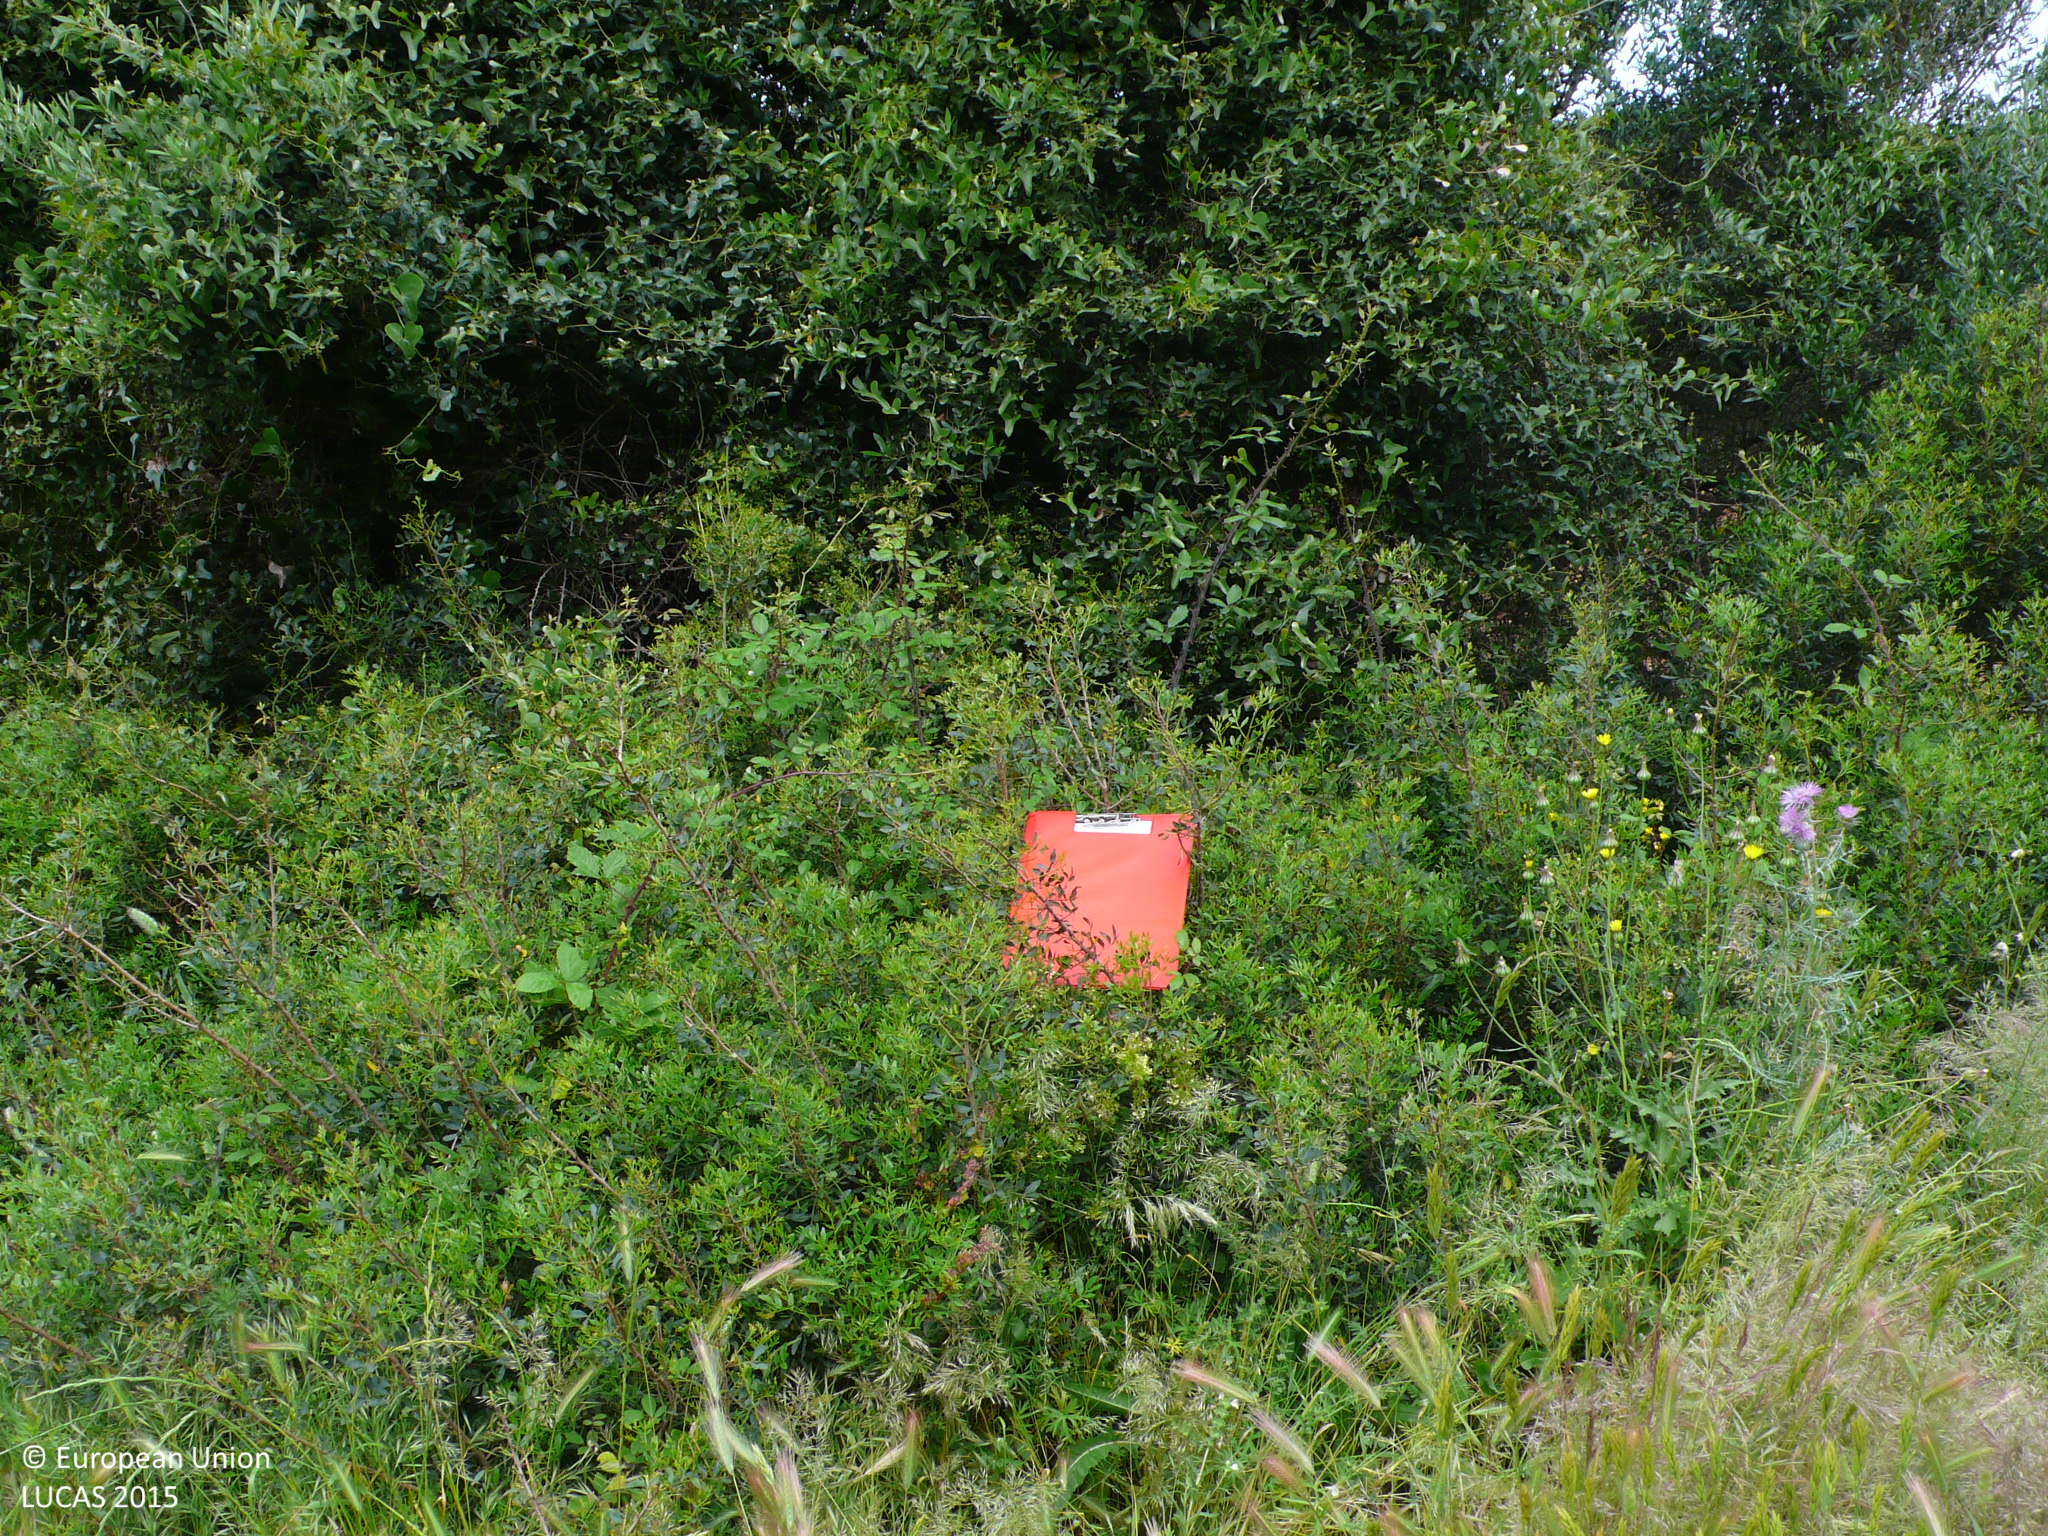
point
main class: Woodland
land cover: Broadleaved woodland
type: broadleaved evergreen forest
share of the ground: 25 - 50 %
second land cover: Grassland without tree/shrub cover
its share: 50 - 75 %
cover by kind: herbaceous plants 50 %, broadleaved forest trees 40 %, shrubs 10 %
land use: Forestry
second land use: Agriculture (excluding fallow land and kitchen gardens)
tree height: > 5 m
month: May
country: ES
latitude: 39.9593
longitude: 4.0442
